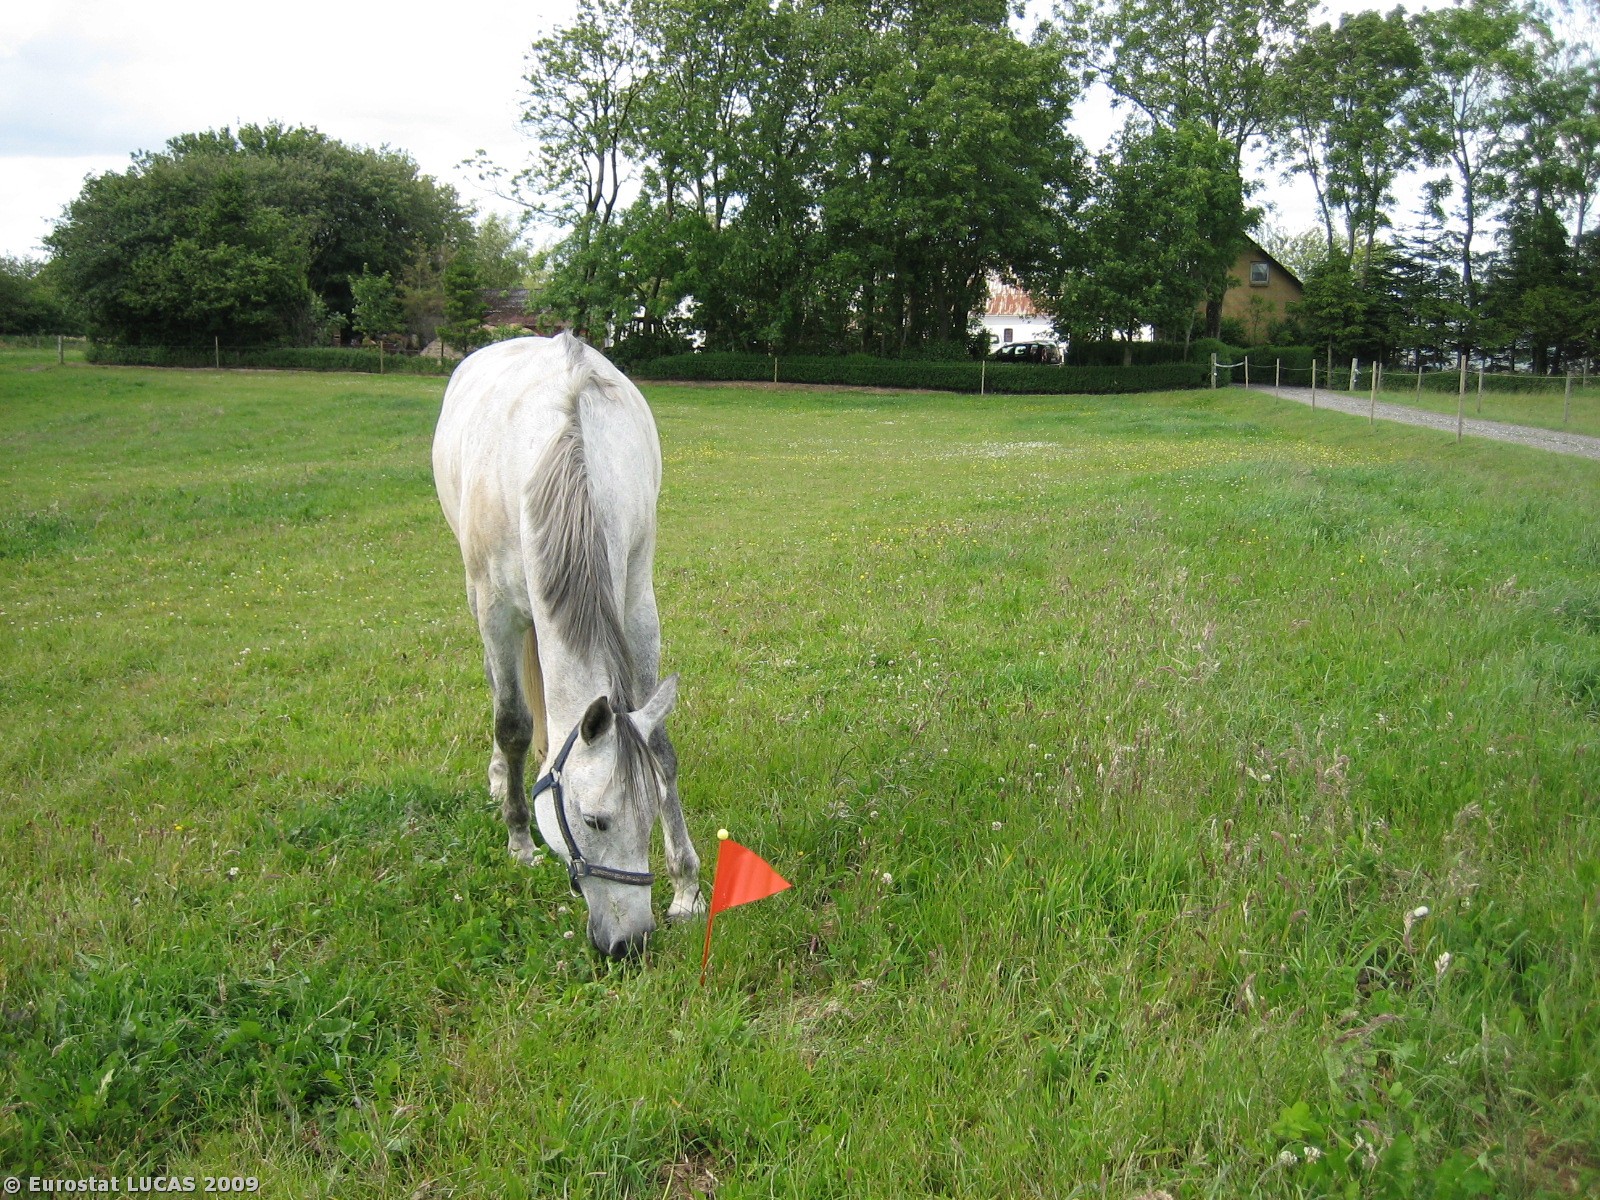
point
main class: Grassland
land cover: Grassland without tree/shrub cover
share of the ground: > 75 %
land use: Agriculture (excluding fallow land and kitchen gardens)
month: June
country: DK
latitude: 55.6285
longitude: 9.2860
